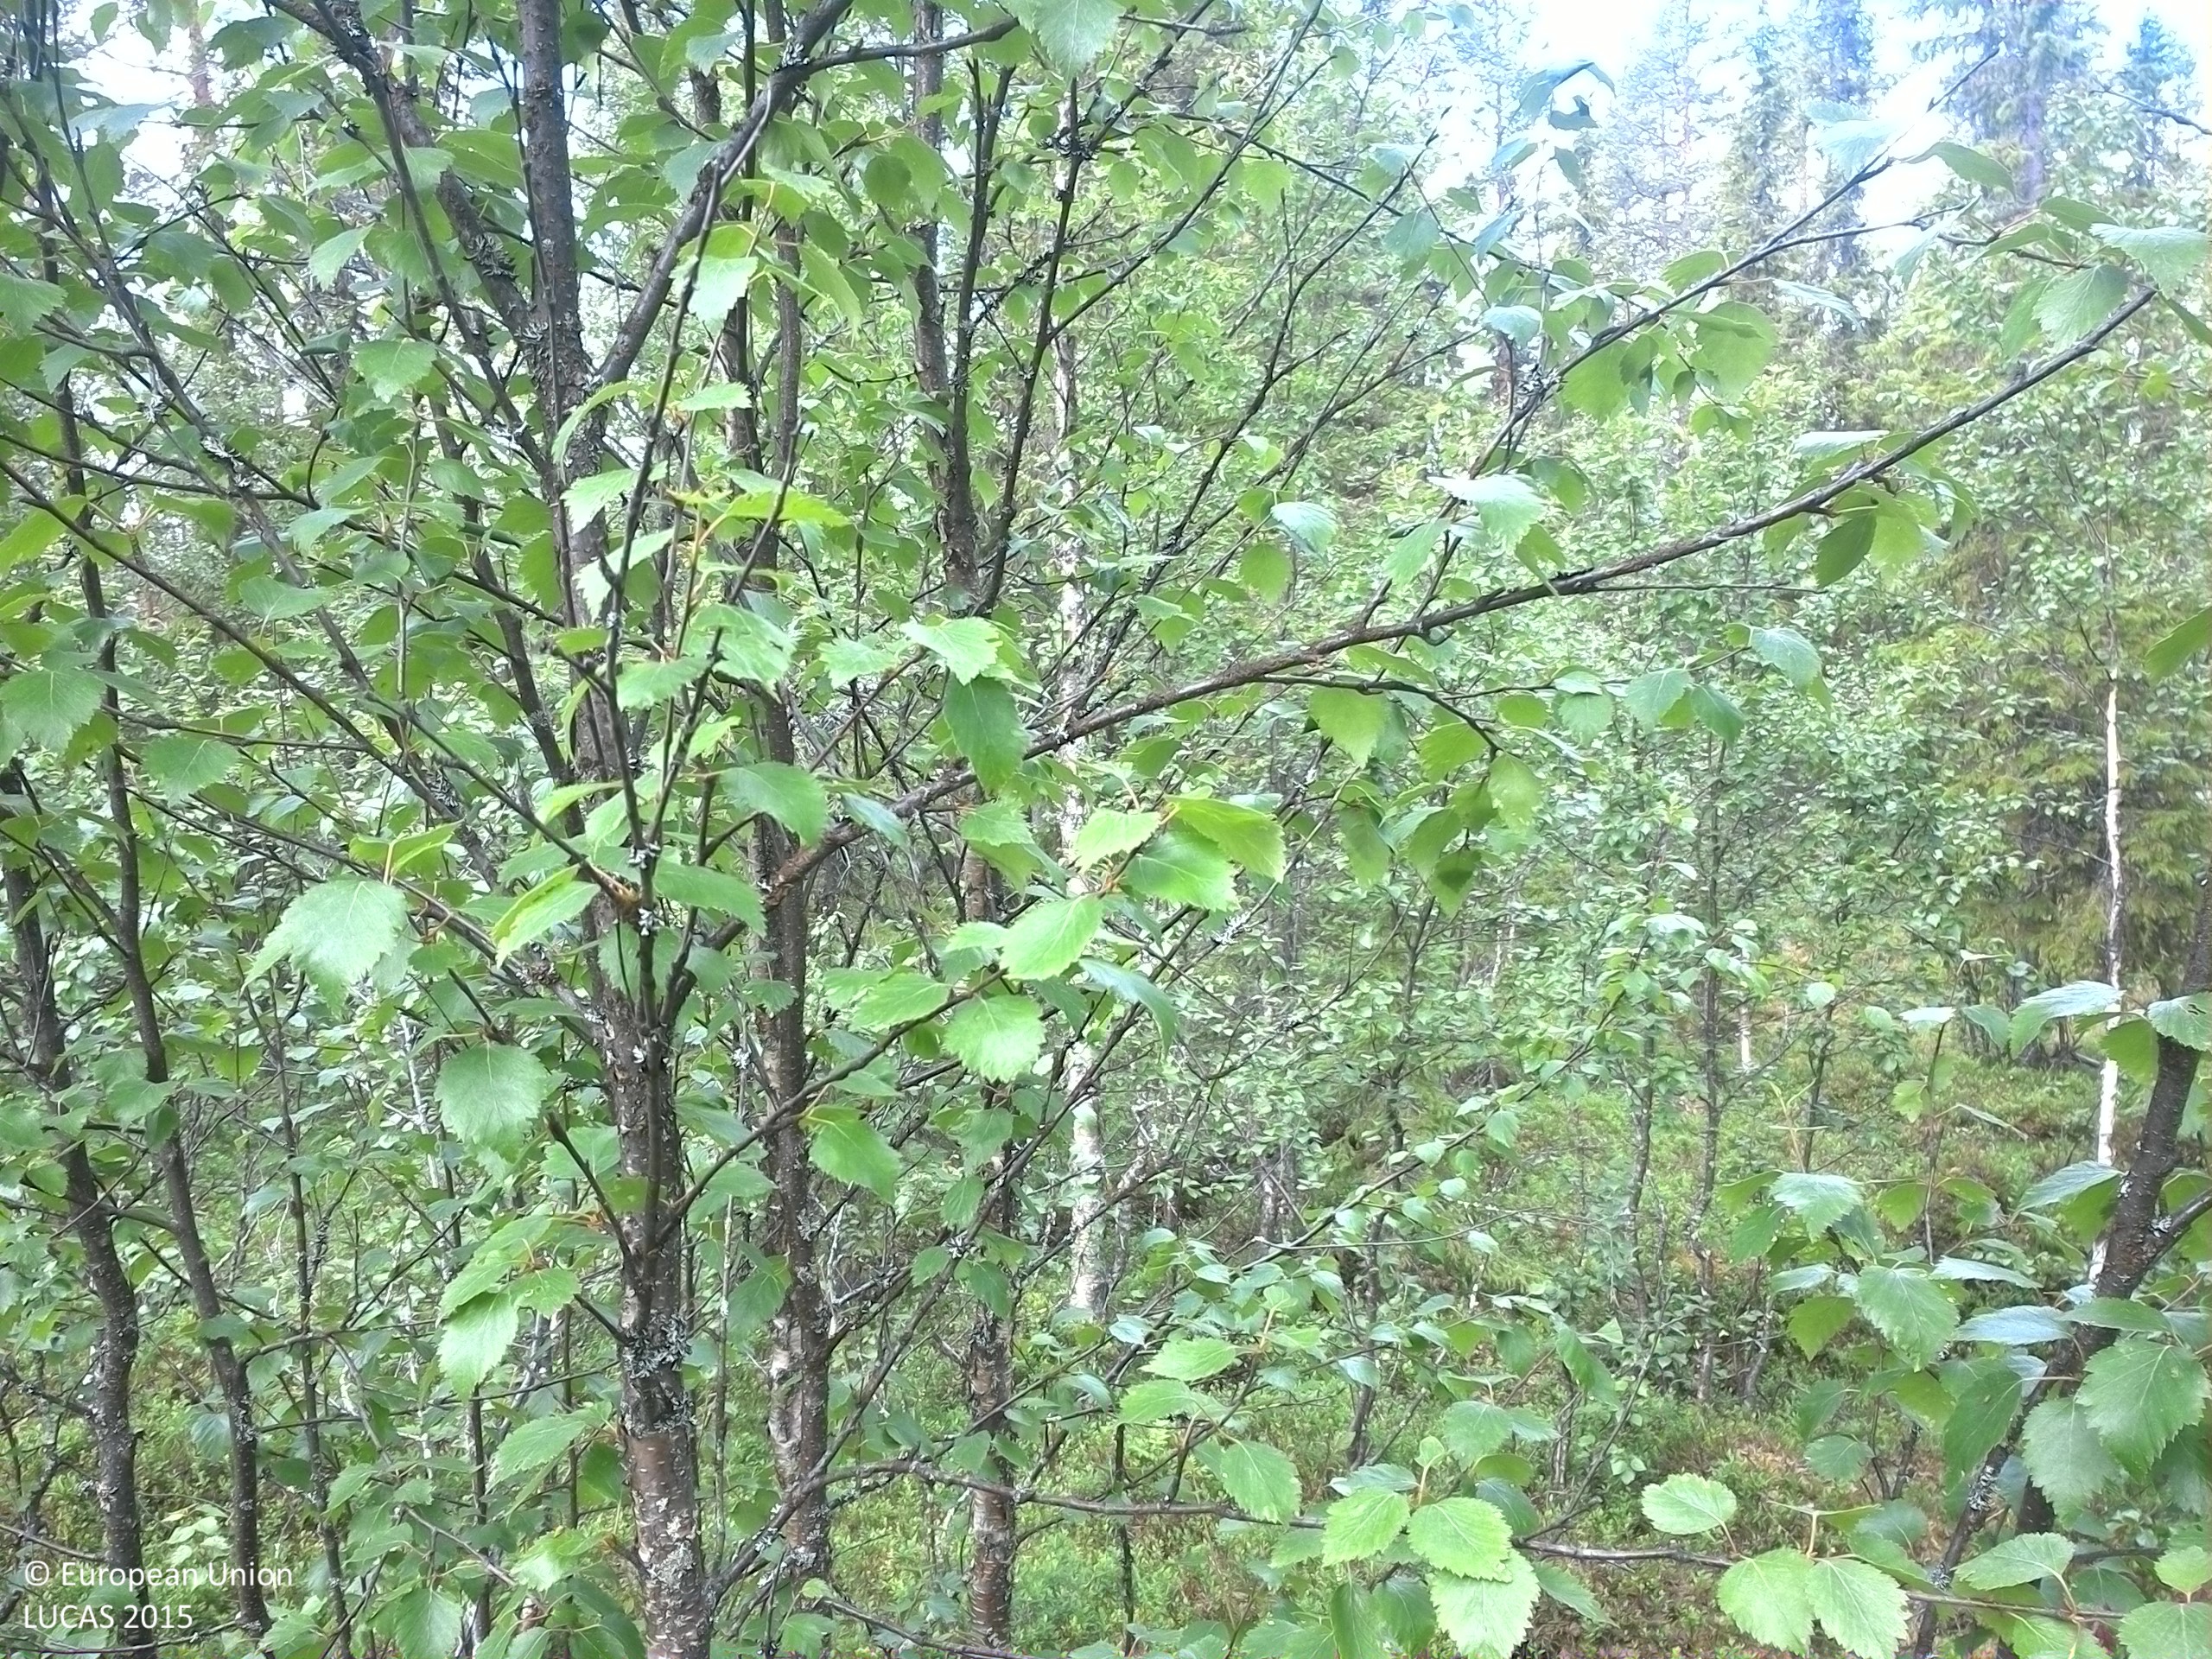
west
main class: Woodland
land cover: Other mixed woodland
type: boreal forest
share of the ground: 50 - 75 %
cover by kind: coniferous forest trees 30 %, shrubs 30 %, broadleaved forest trees 25 %, lichens and mosses 15 %
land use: Forestry
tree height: > 5 m
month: July
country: SE
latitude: 64.7168
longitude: 15.5717
